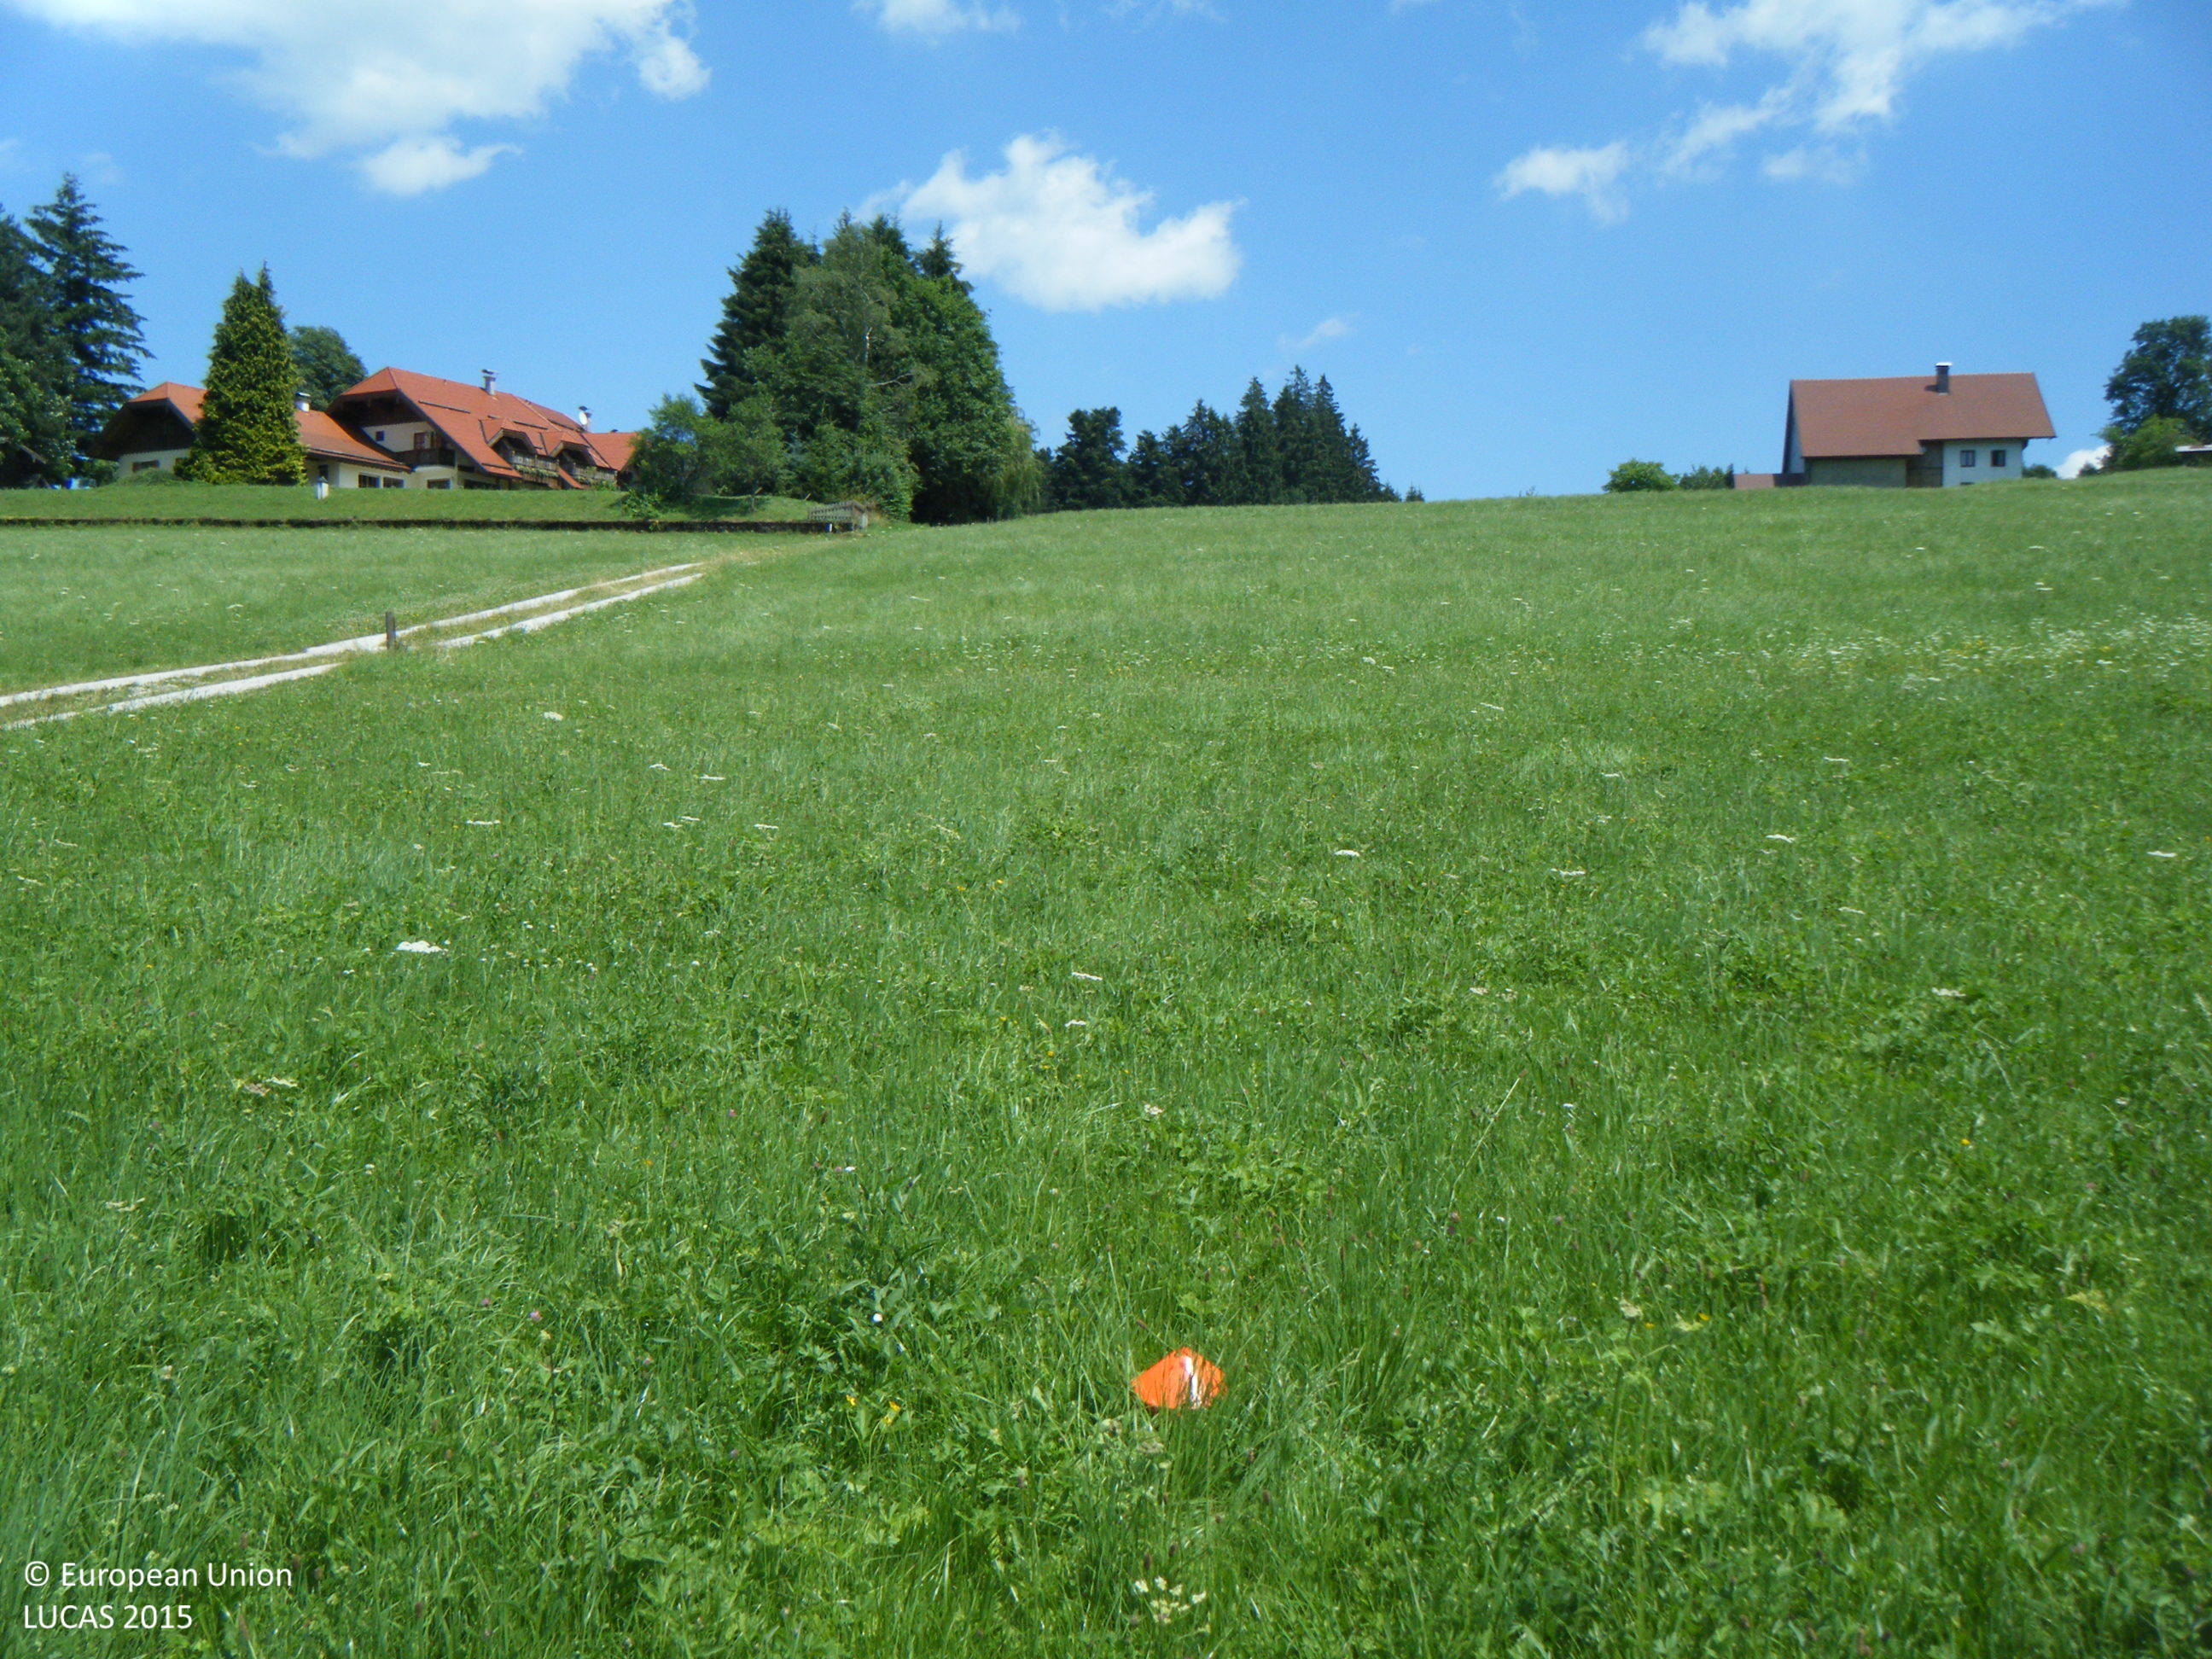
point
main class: Grassland
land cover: Grassland without tree/shrub cover
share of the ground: > 75 %
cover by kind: herbaceous plants 100 %
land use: Agriculture (excluding fallow land and kitchen gardens)
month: July
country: AT
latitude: 47.8442
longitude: 13.4864
